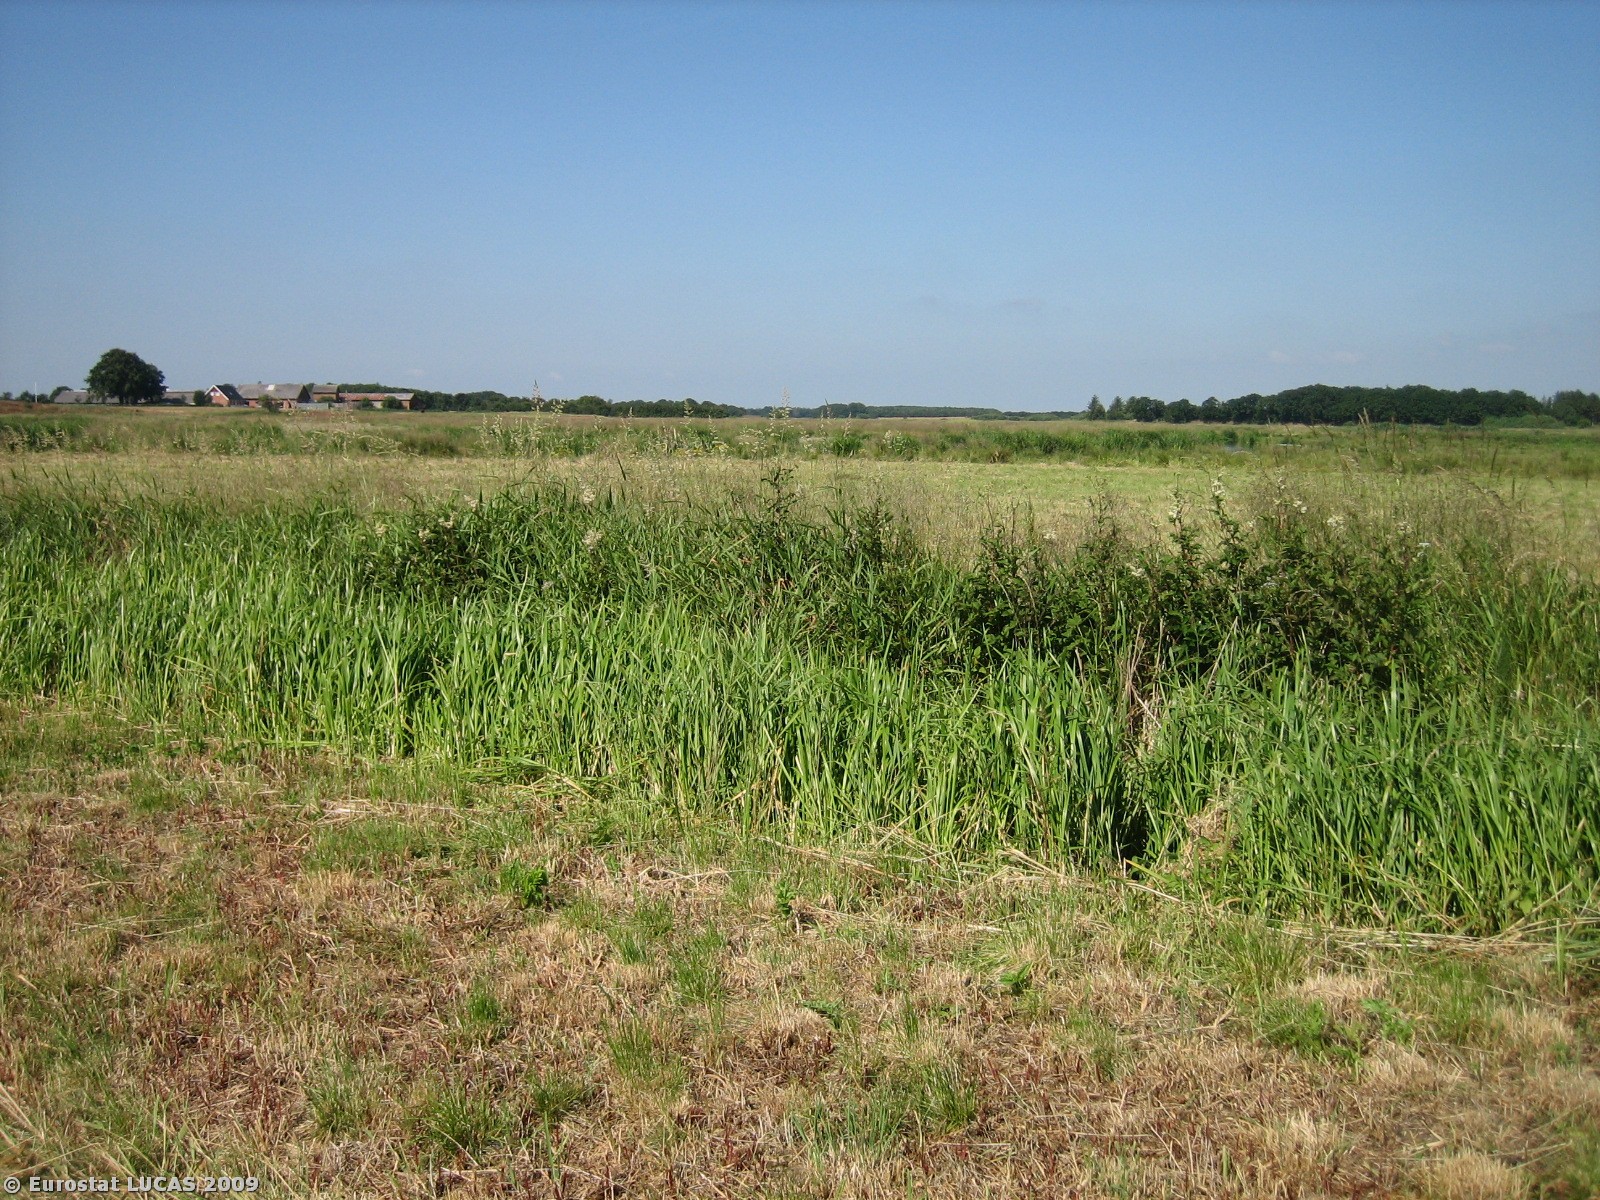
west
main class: Cropland
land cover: Temporary grasslands
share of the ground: > 75 %
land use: Agriculture (excluding fallow land and kitchen gardens)
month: July
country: DK
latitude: 55.4099
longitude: 8.8796
